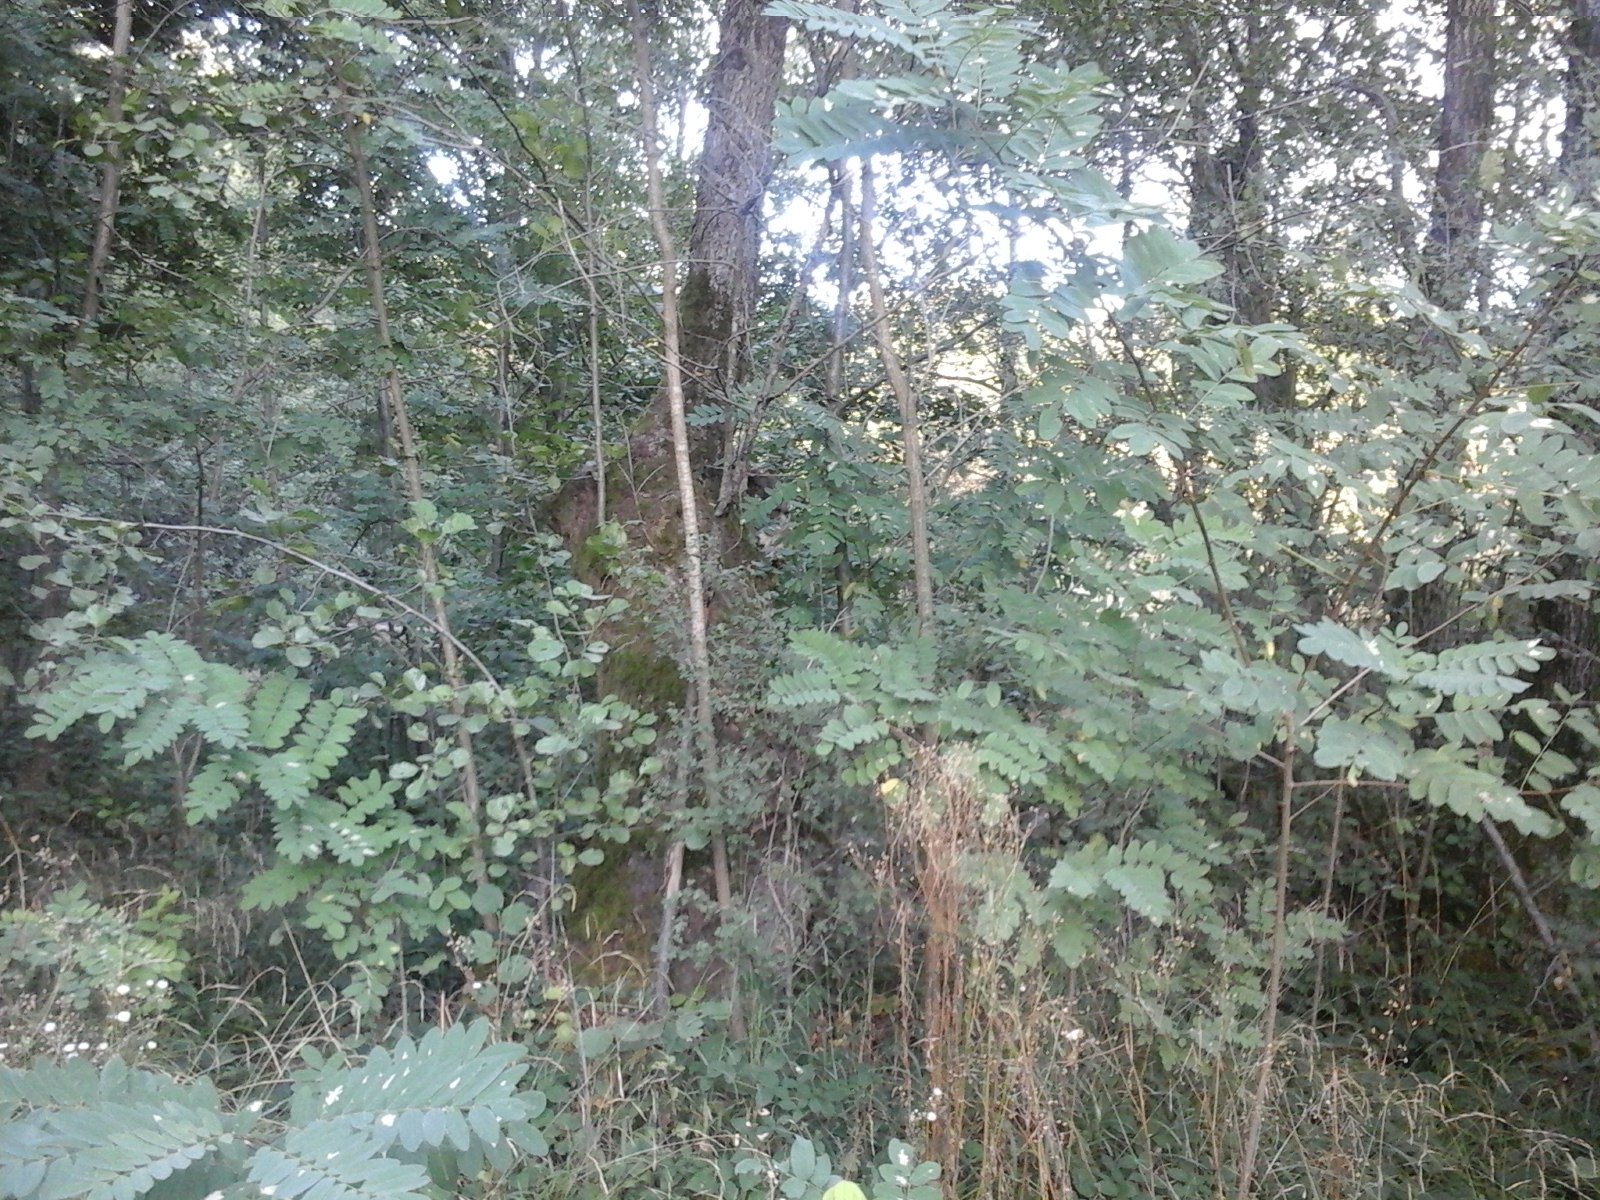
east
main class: Woodland
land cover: Broadleaved woodland
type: exotic forest
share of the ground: > 75 %
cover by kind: broadleaved forest trees 100 %
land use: Forestry
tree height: > 5 m
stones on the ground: < 10 %
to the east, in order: Broadleaved woodland; Rivers and streams; Broadleaved woodland; Tracks; Spontaneously vegetated surfaces; Other fruit trees and berries; Broadleaved woodland
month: September
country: RO
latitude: 47.9419
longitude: 23.4496
